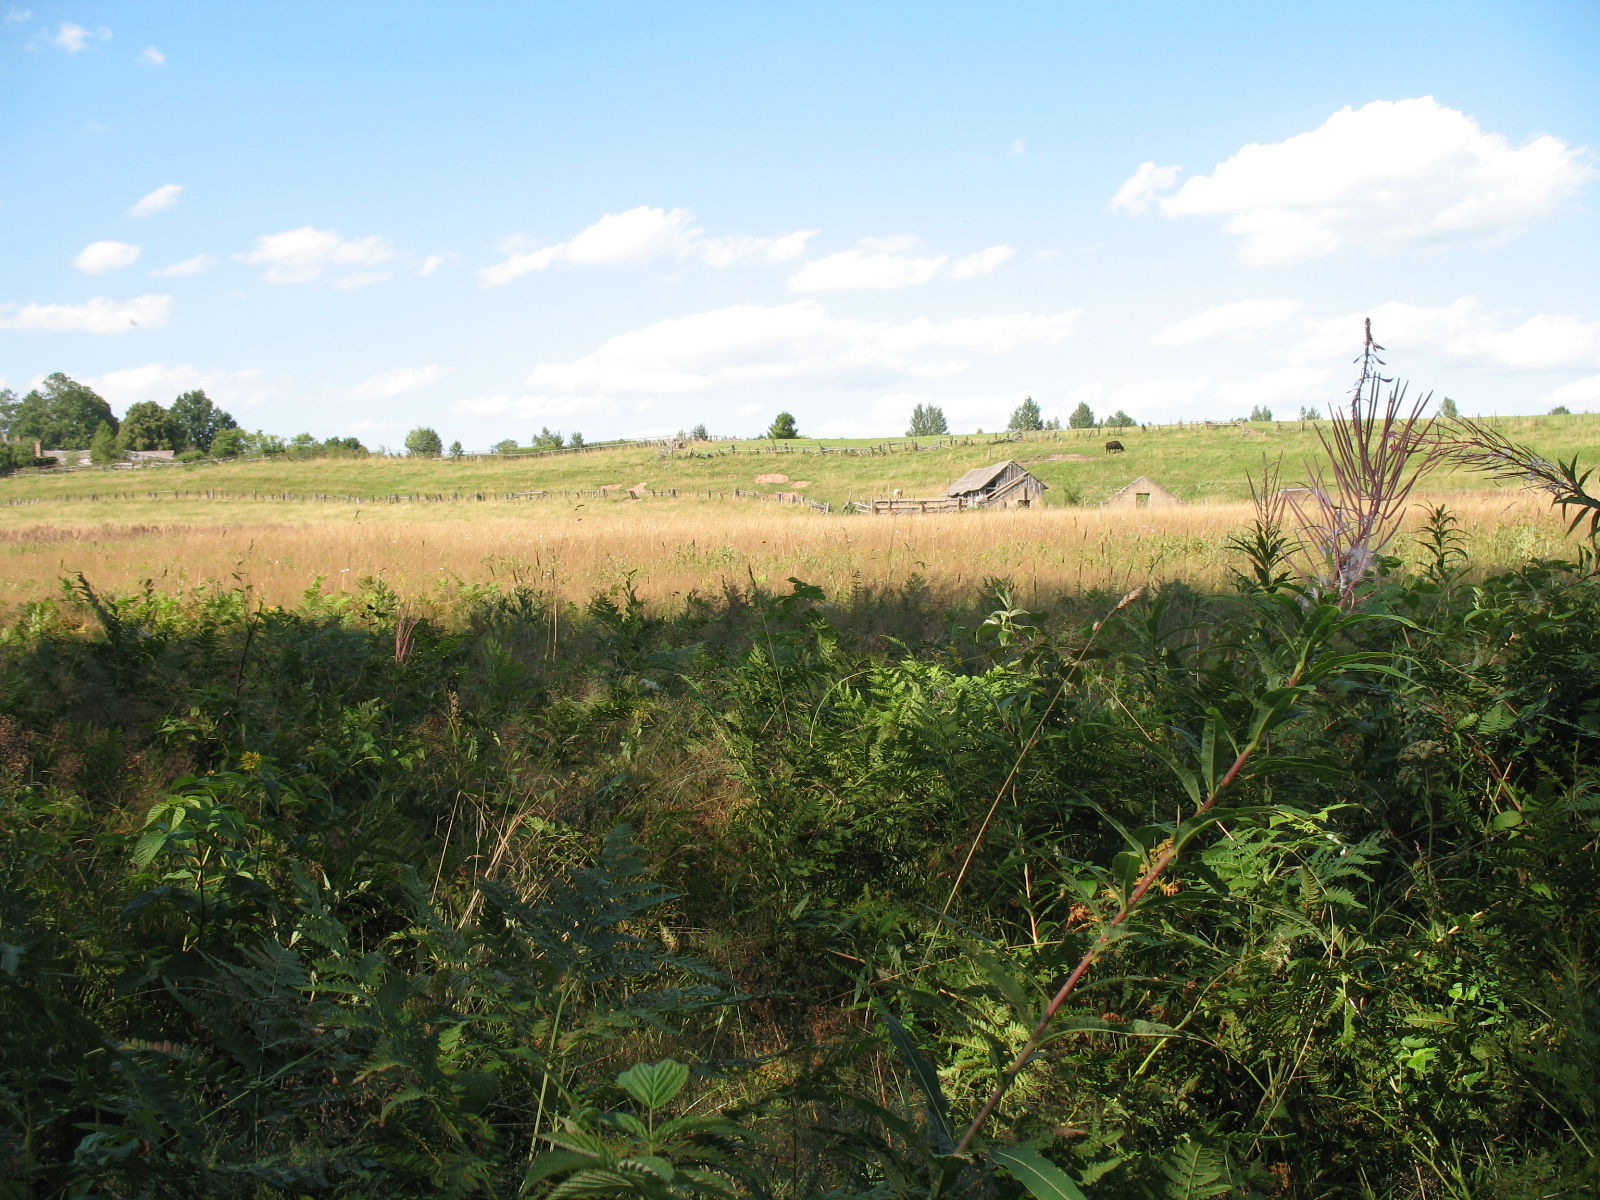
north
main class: Grassland
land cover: Spontaneously vegetated surfaces
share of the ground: > 75 %
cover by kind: herbaceous plants 100 %
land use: Agriculture (excluding fallow land and kitchen gardens)
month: August
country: LV
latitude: 56.5513
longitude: 25.2586
